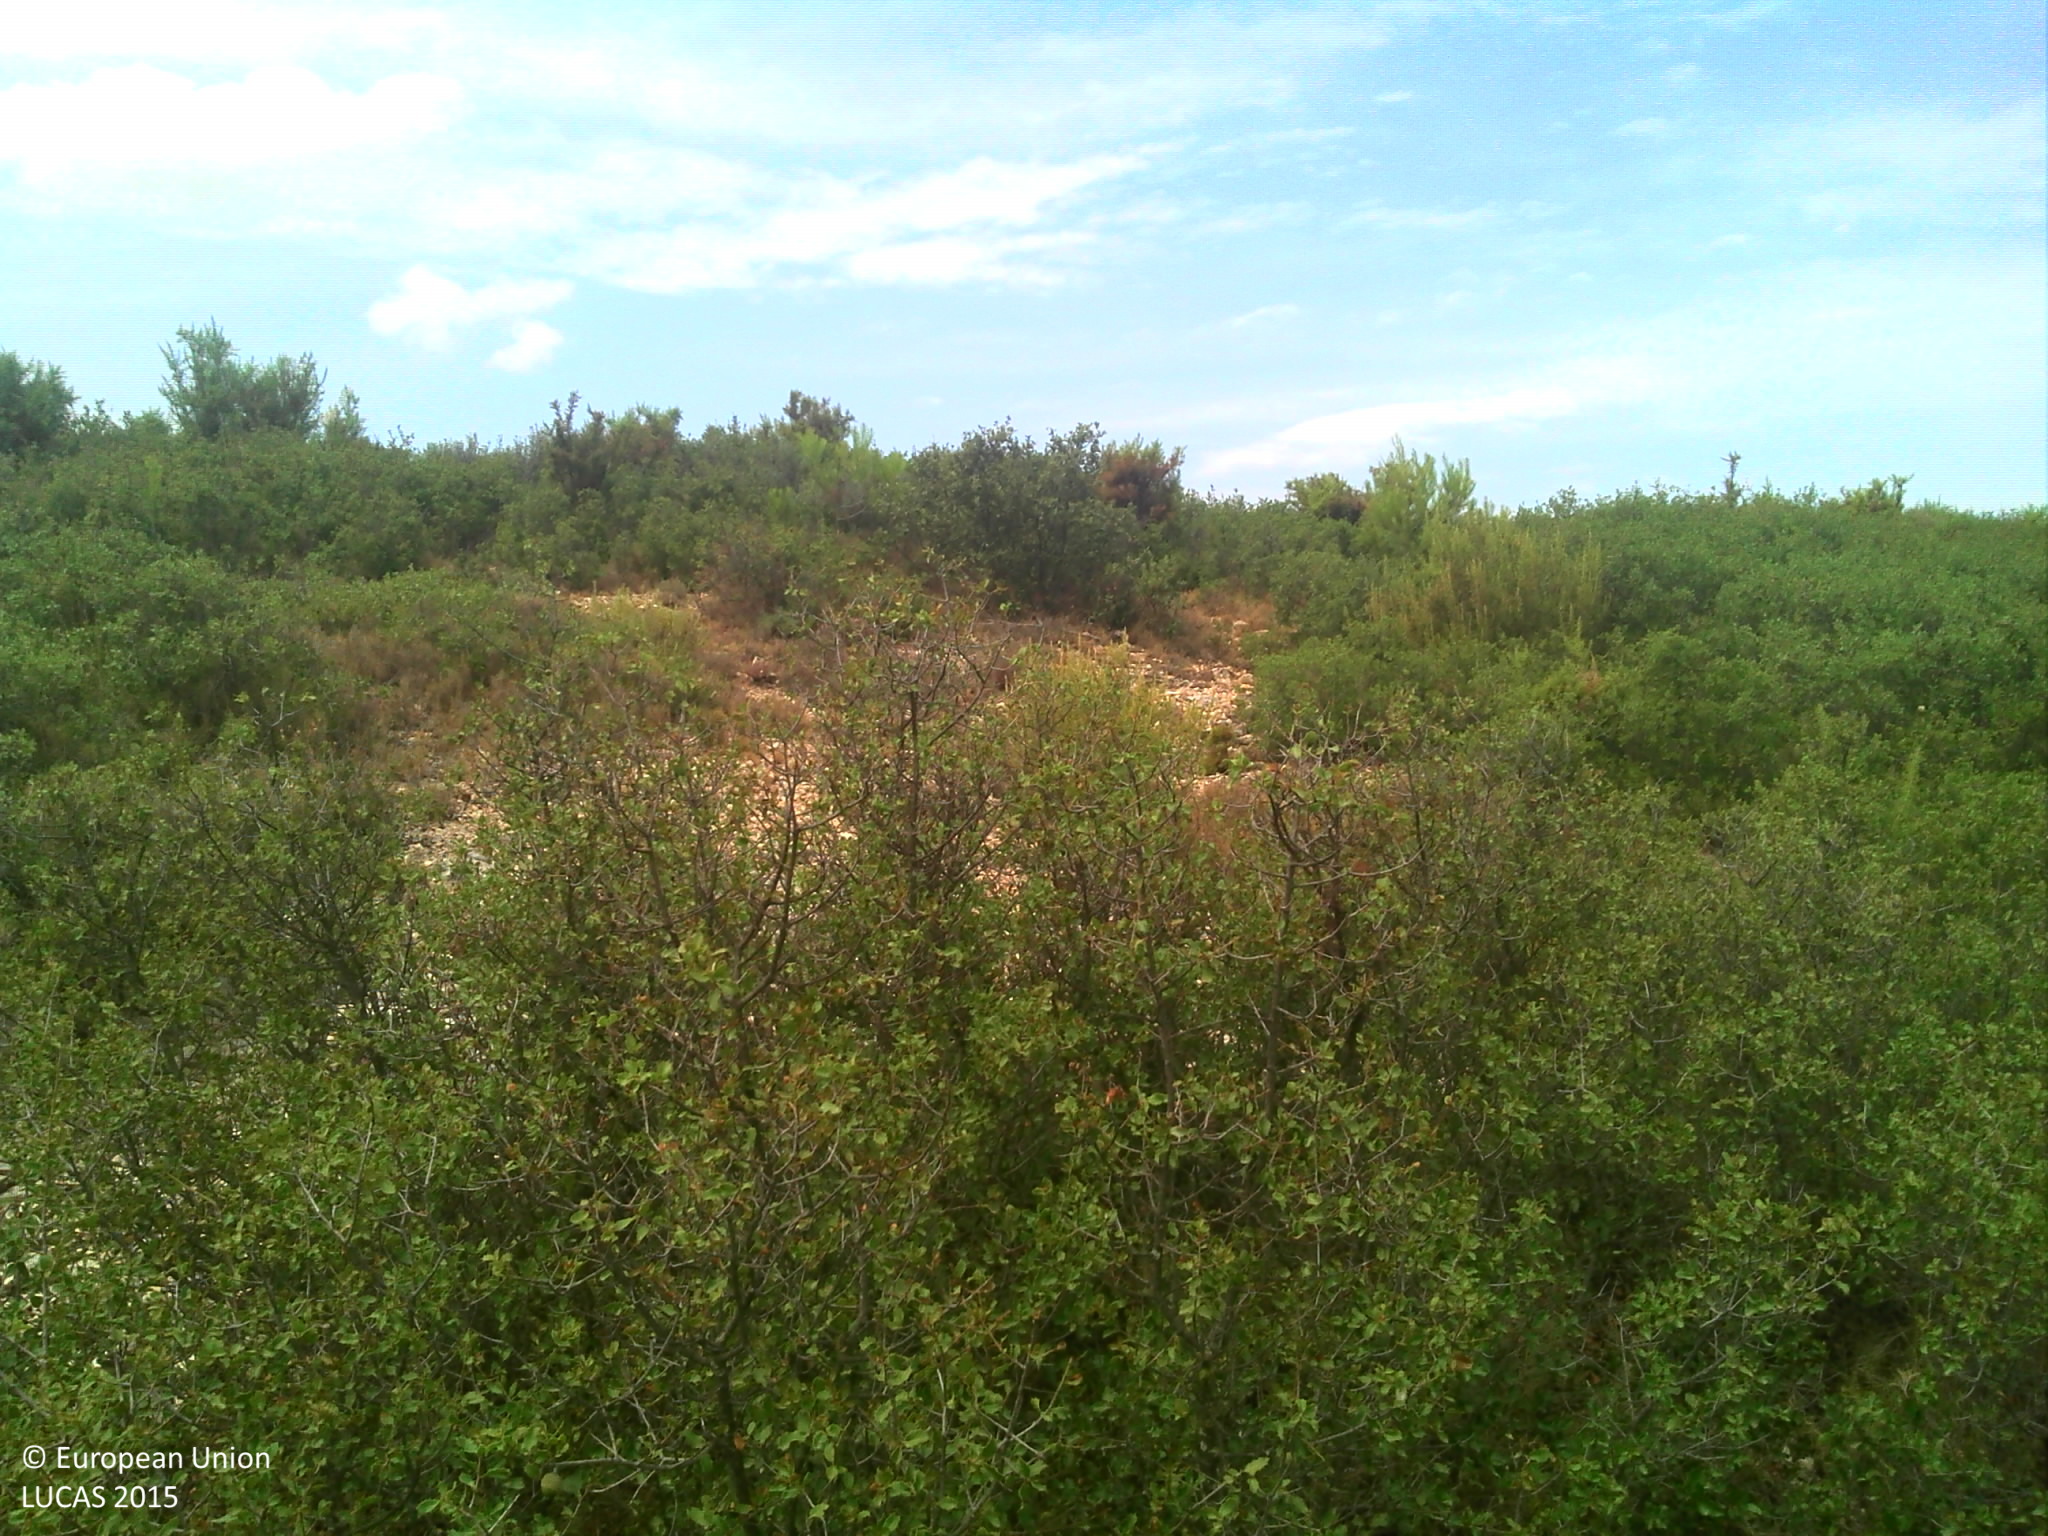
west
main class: Shrubland
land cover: Shrubland without tree cover
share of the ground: > 75 %
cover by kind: shrubs 95 %, unconsolidated bare surface 5 %
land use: Semi-natural and natural areas not in use
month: August
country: FR
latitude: 43.4874
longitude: 5.3483
